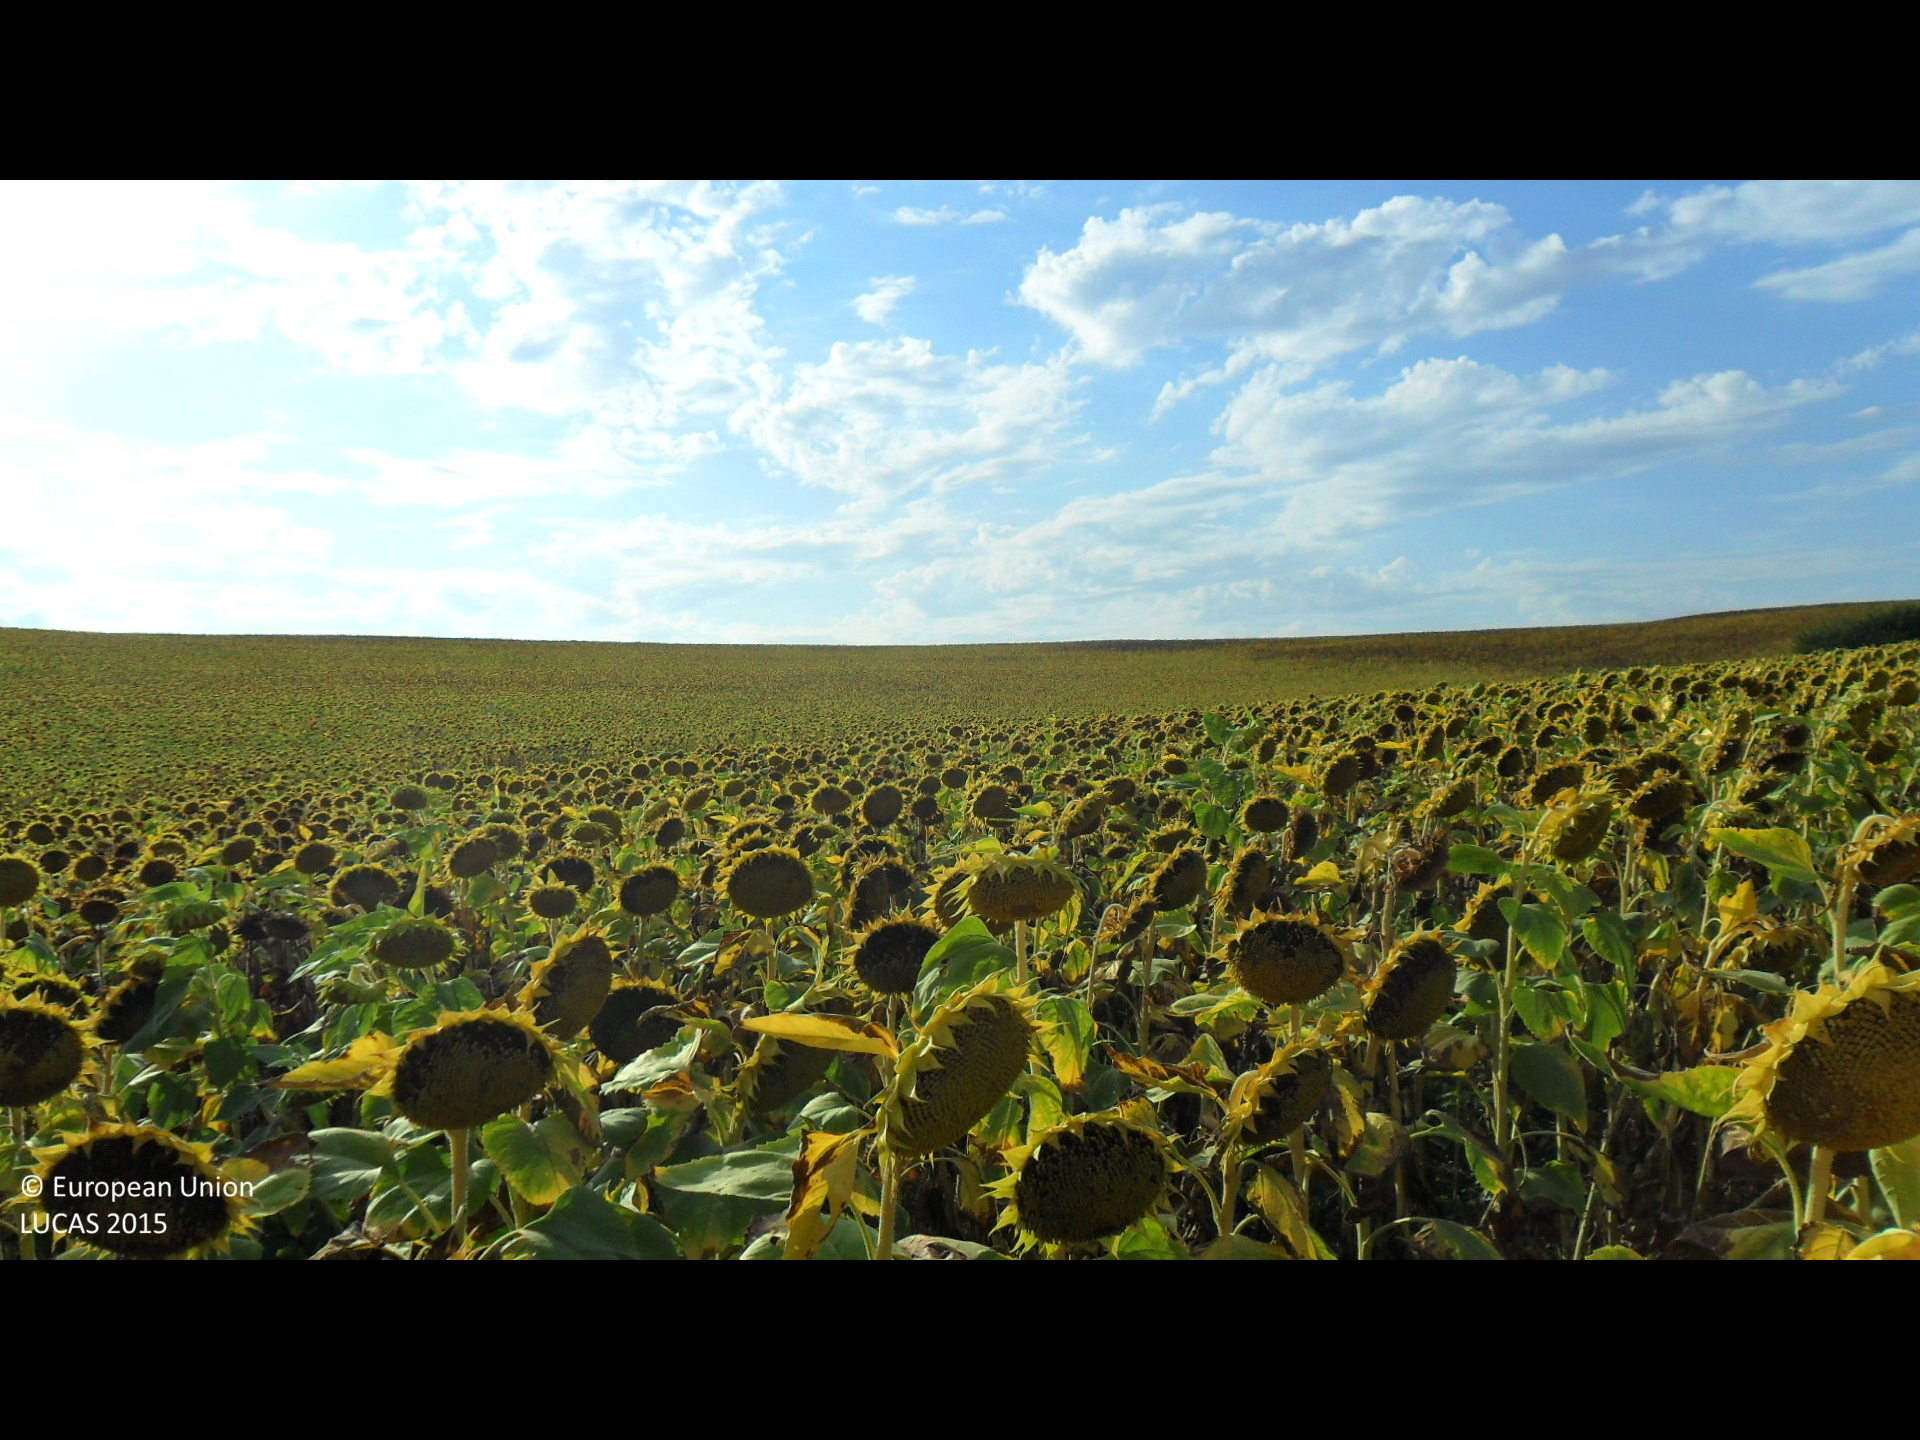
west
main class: Cropland
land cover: Sunflower
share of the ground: > 75 %
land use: Agriculture (excluding fallow land and kitchen gardens)
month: August
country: BG
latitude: 43.3692
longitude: 26.1502
